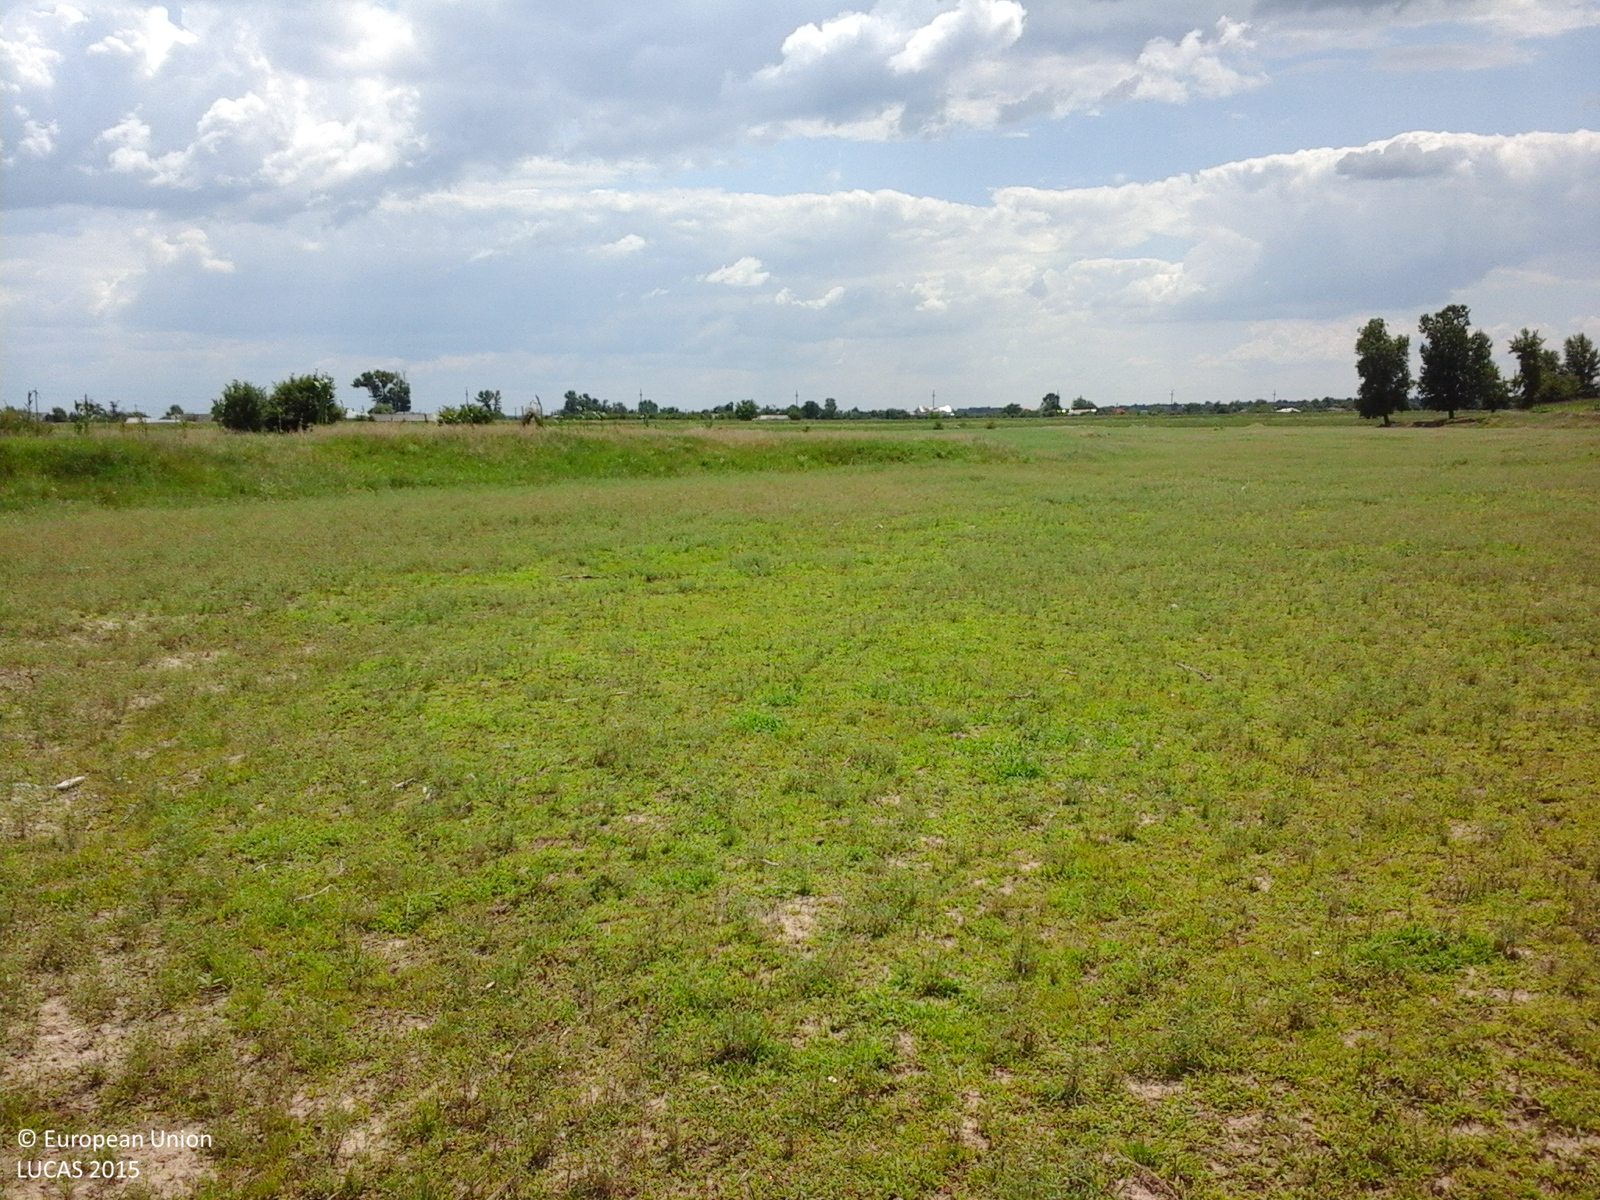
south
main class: Grassland
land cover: Spontaneously vegetated surfaces
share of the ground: > 75 %
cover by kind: herbaceous plants 100 %
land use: Agriculture (excluding fallow land and kitchen gardens)
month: July
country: RO
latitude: 44.2931
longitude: 24.7754
